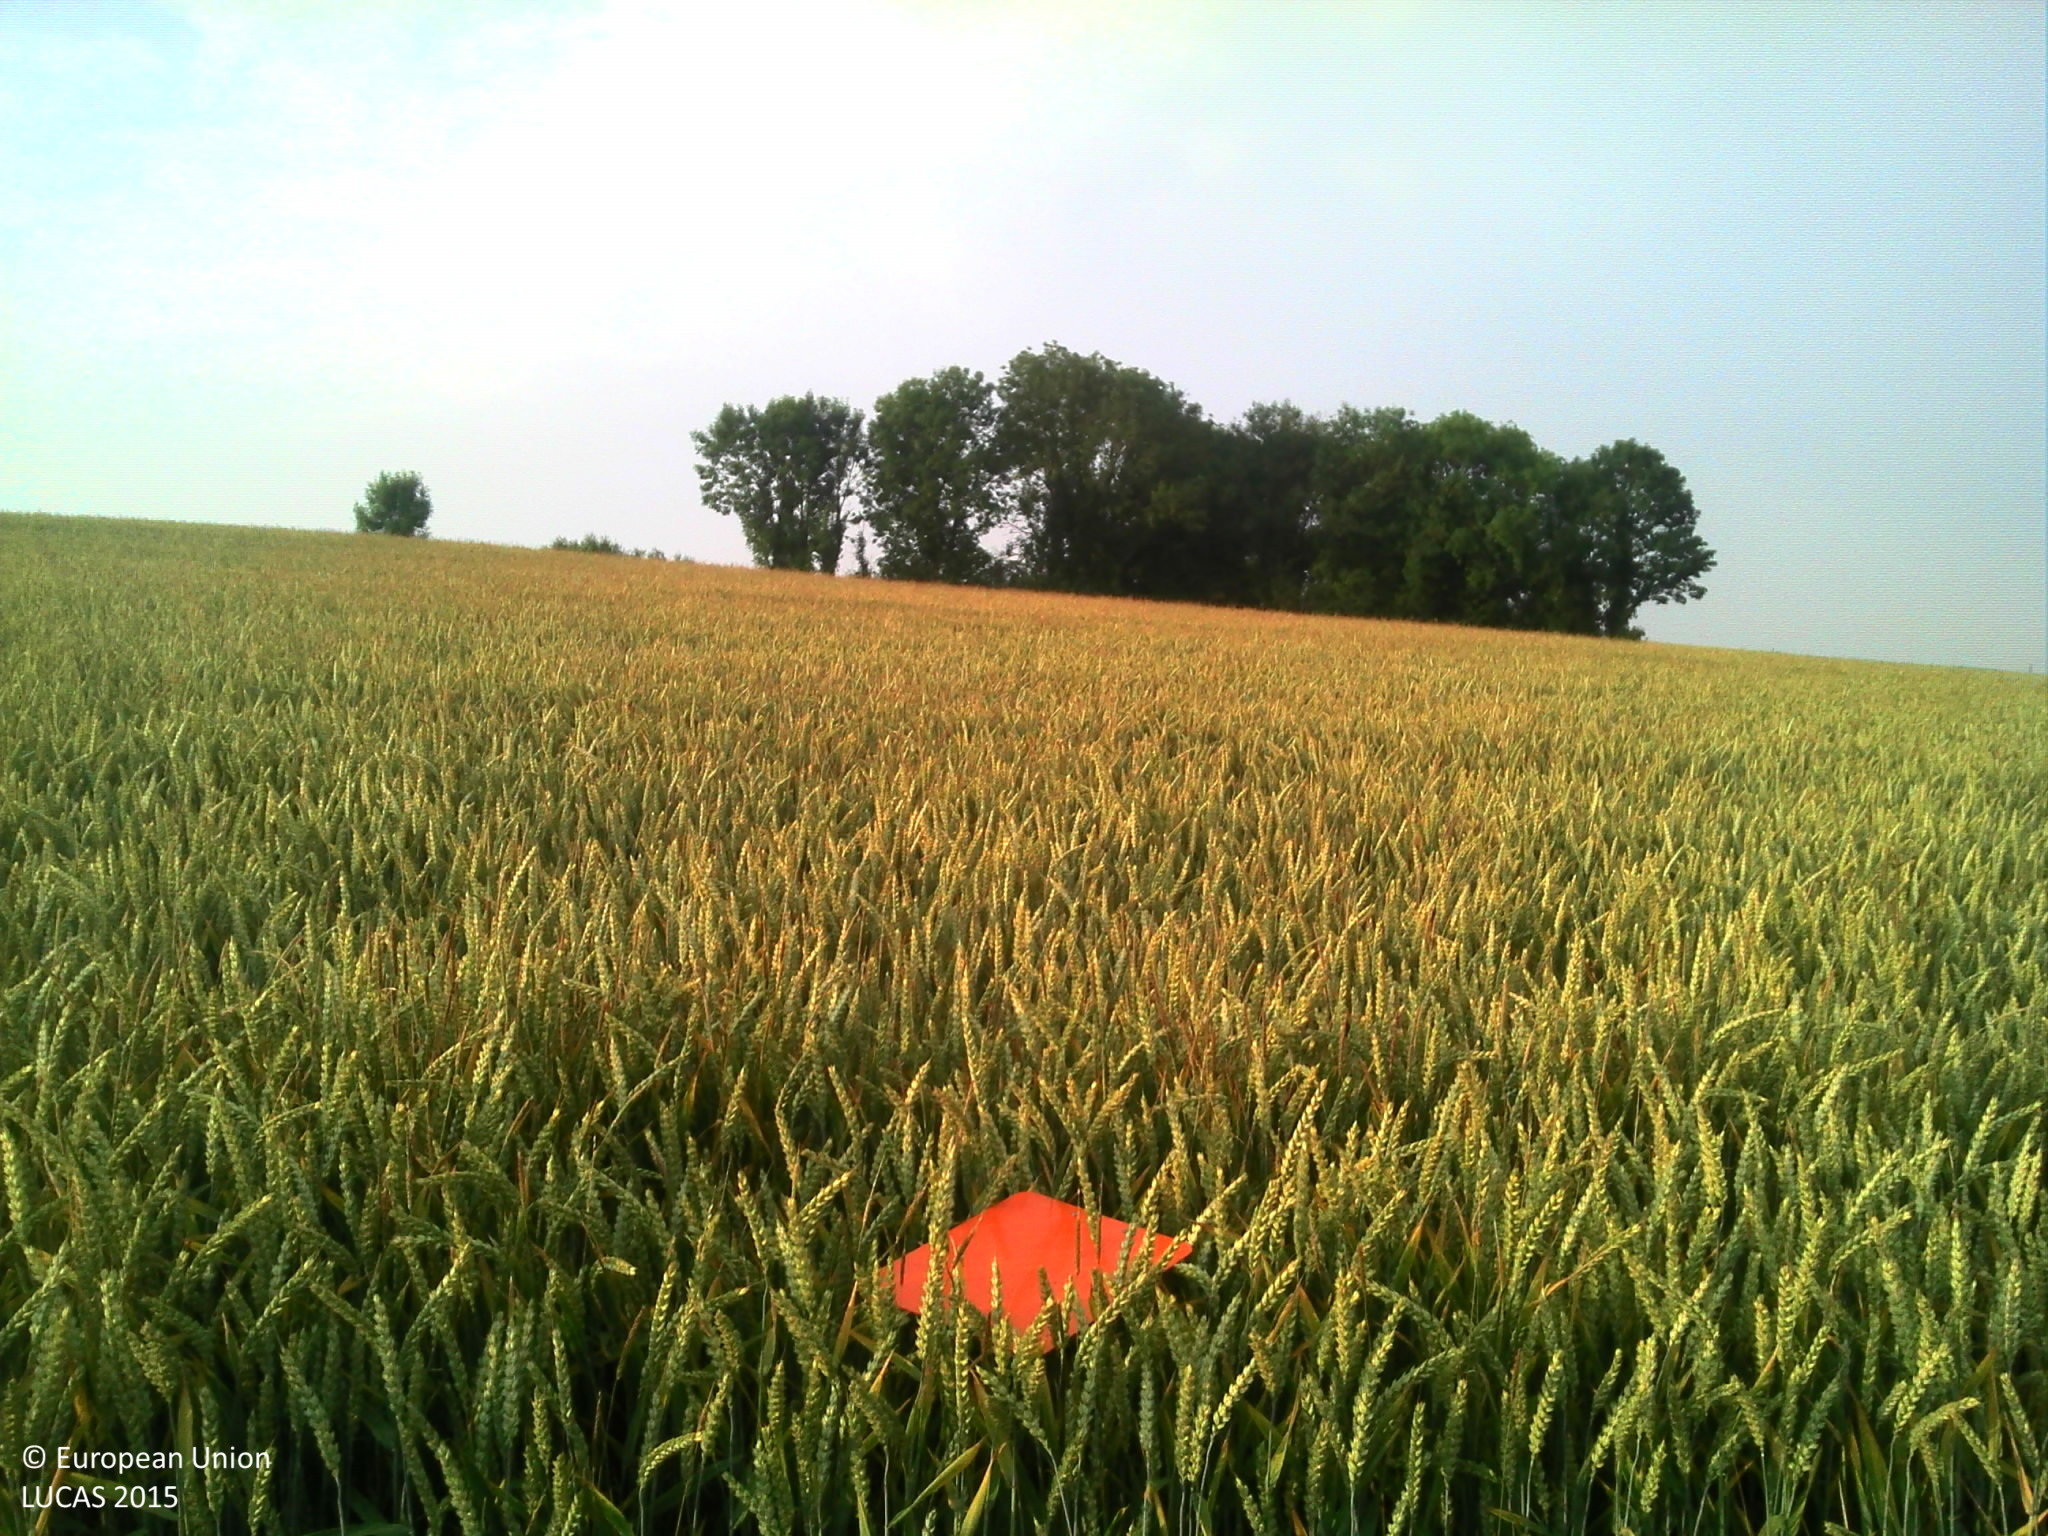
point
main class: Cropland
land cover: Common wheat
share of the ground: > 75 %
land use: Agriculture (excluding fallow land and kitchen gardens)
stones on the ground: 10 - 25 %
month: July
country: FR
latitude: 49.7852
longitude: 2.3898
